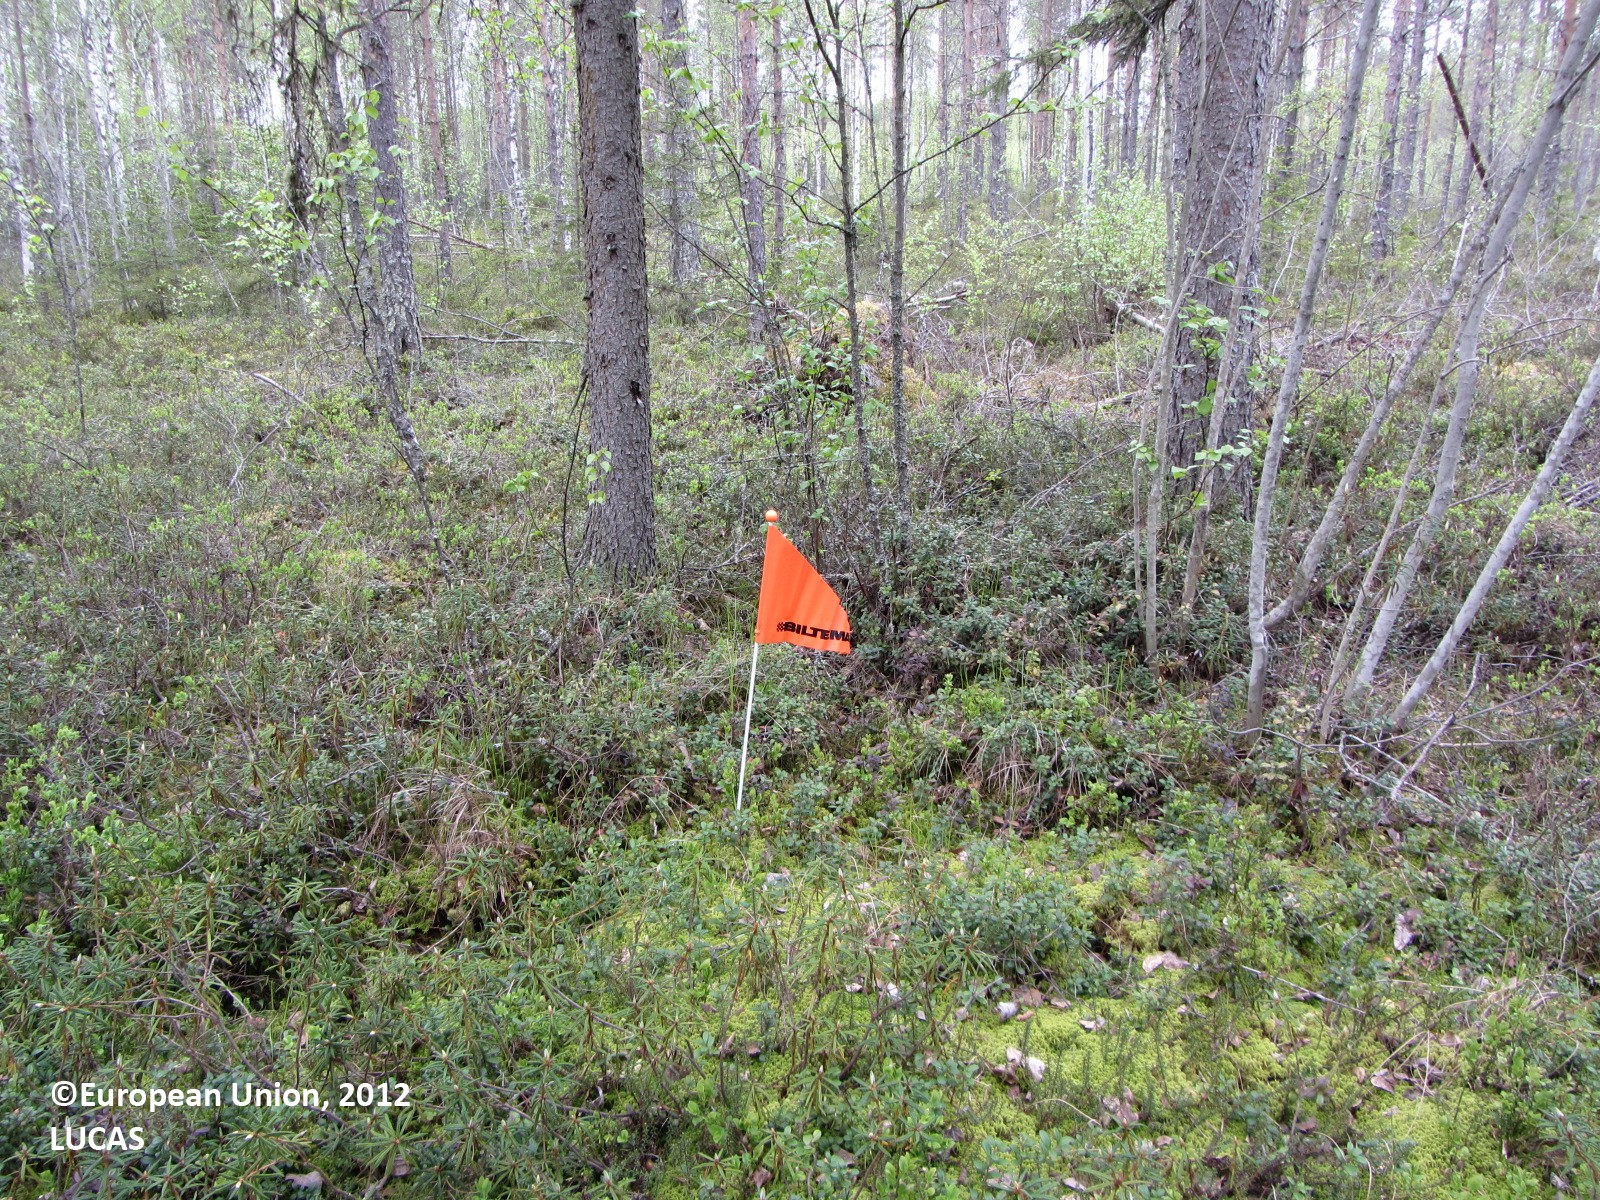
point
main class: Woodland
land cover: Pine dominated mixed woodland
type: boreal forest
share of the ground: > 75 %
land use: Forestry
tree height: > 5 m
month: June
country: FI
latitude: 63.8378
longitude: 24.6962
